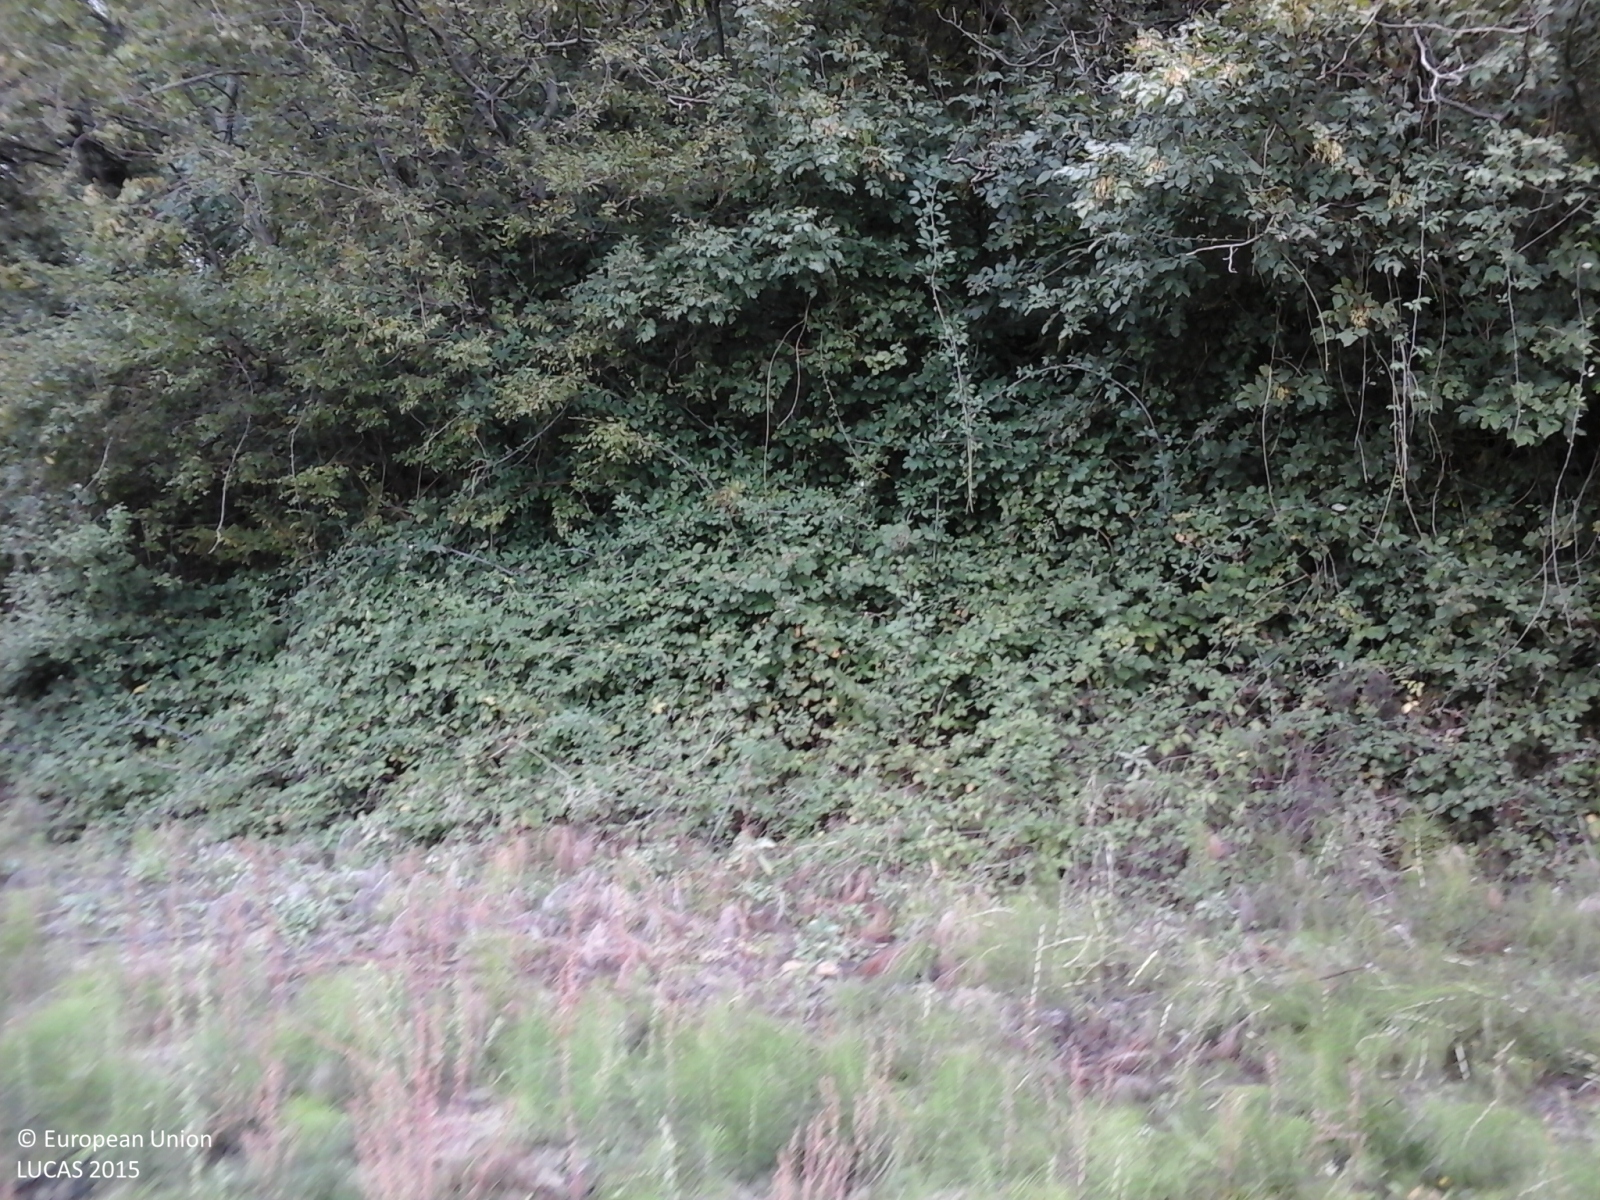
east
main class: Woodland
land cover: Broadleaved woodland
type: thermophilous deciduous forest
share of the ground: > 75 %
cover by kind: broadleaved forest trees 100 %
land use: Forestry
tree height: > 5 m
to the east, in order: Broadleaved woodland; Durum wheat; Abandoned hedges; Spontaneously vegetated surfaces
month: October
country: IT
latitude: 43.4761
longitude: 13.0212
